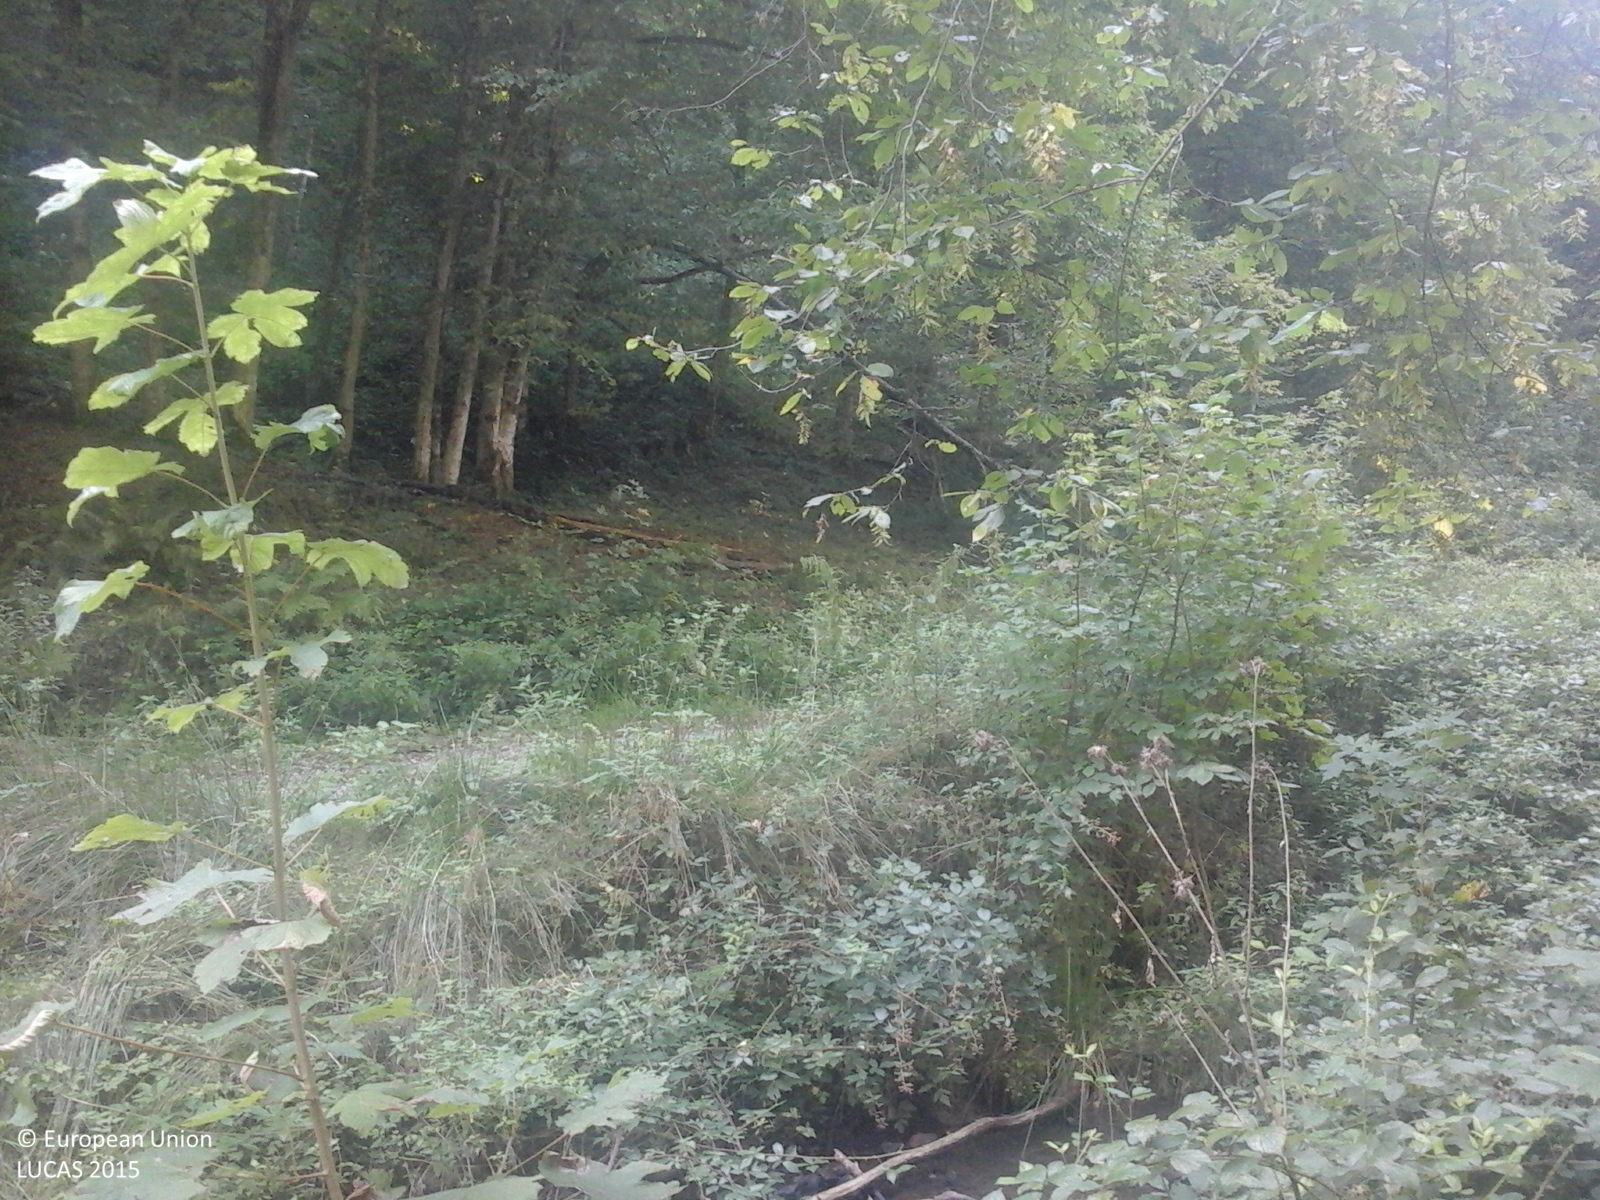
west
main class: Woodland
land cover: Broadleaved woodland
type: beech forest
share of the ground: > 75 %
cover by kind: broadleaved forest trees 100 %
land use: Forestry
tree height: > 5 m
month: August
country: RO
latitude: 46.5788
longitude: 22.1962
